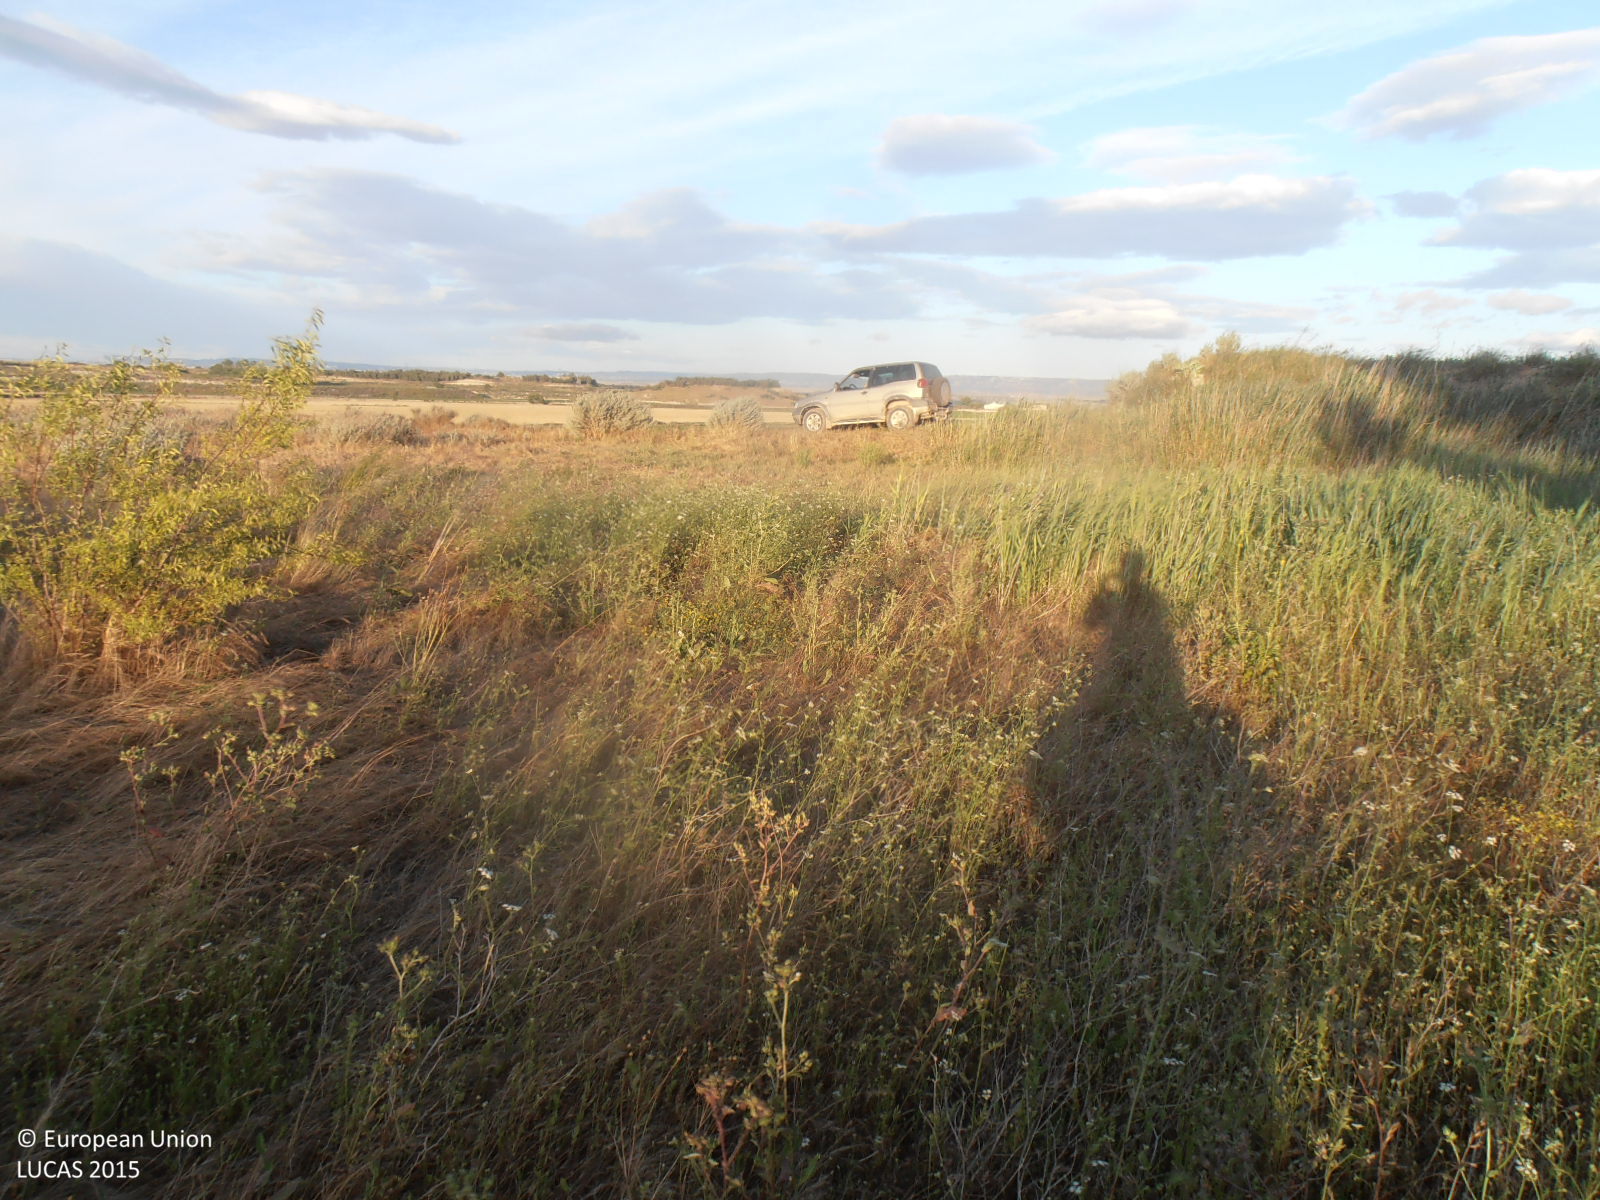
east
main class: Grassland
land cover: Grassland without tree/shrub cover
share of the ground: > 75 %
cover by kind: herbaceous plants 100 %
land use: Abandoned areas
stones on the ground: < 10 %
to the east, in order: Grassland without tree/shrub cover; Tracks; Grass margins; Lucerne; Shruby margins; Lucerne; Grass margins; Lucerne; Grass margins; Lucerne
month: June
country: ES
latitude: 41.9460
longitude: -1.3065
